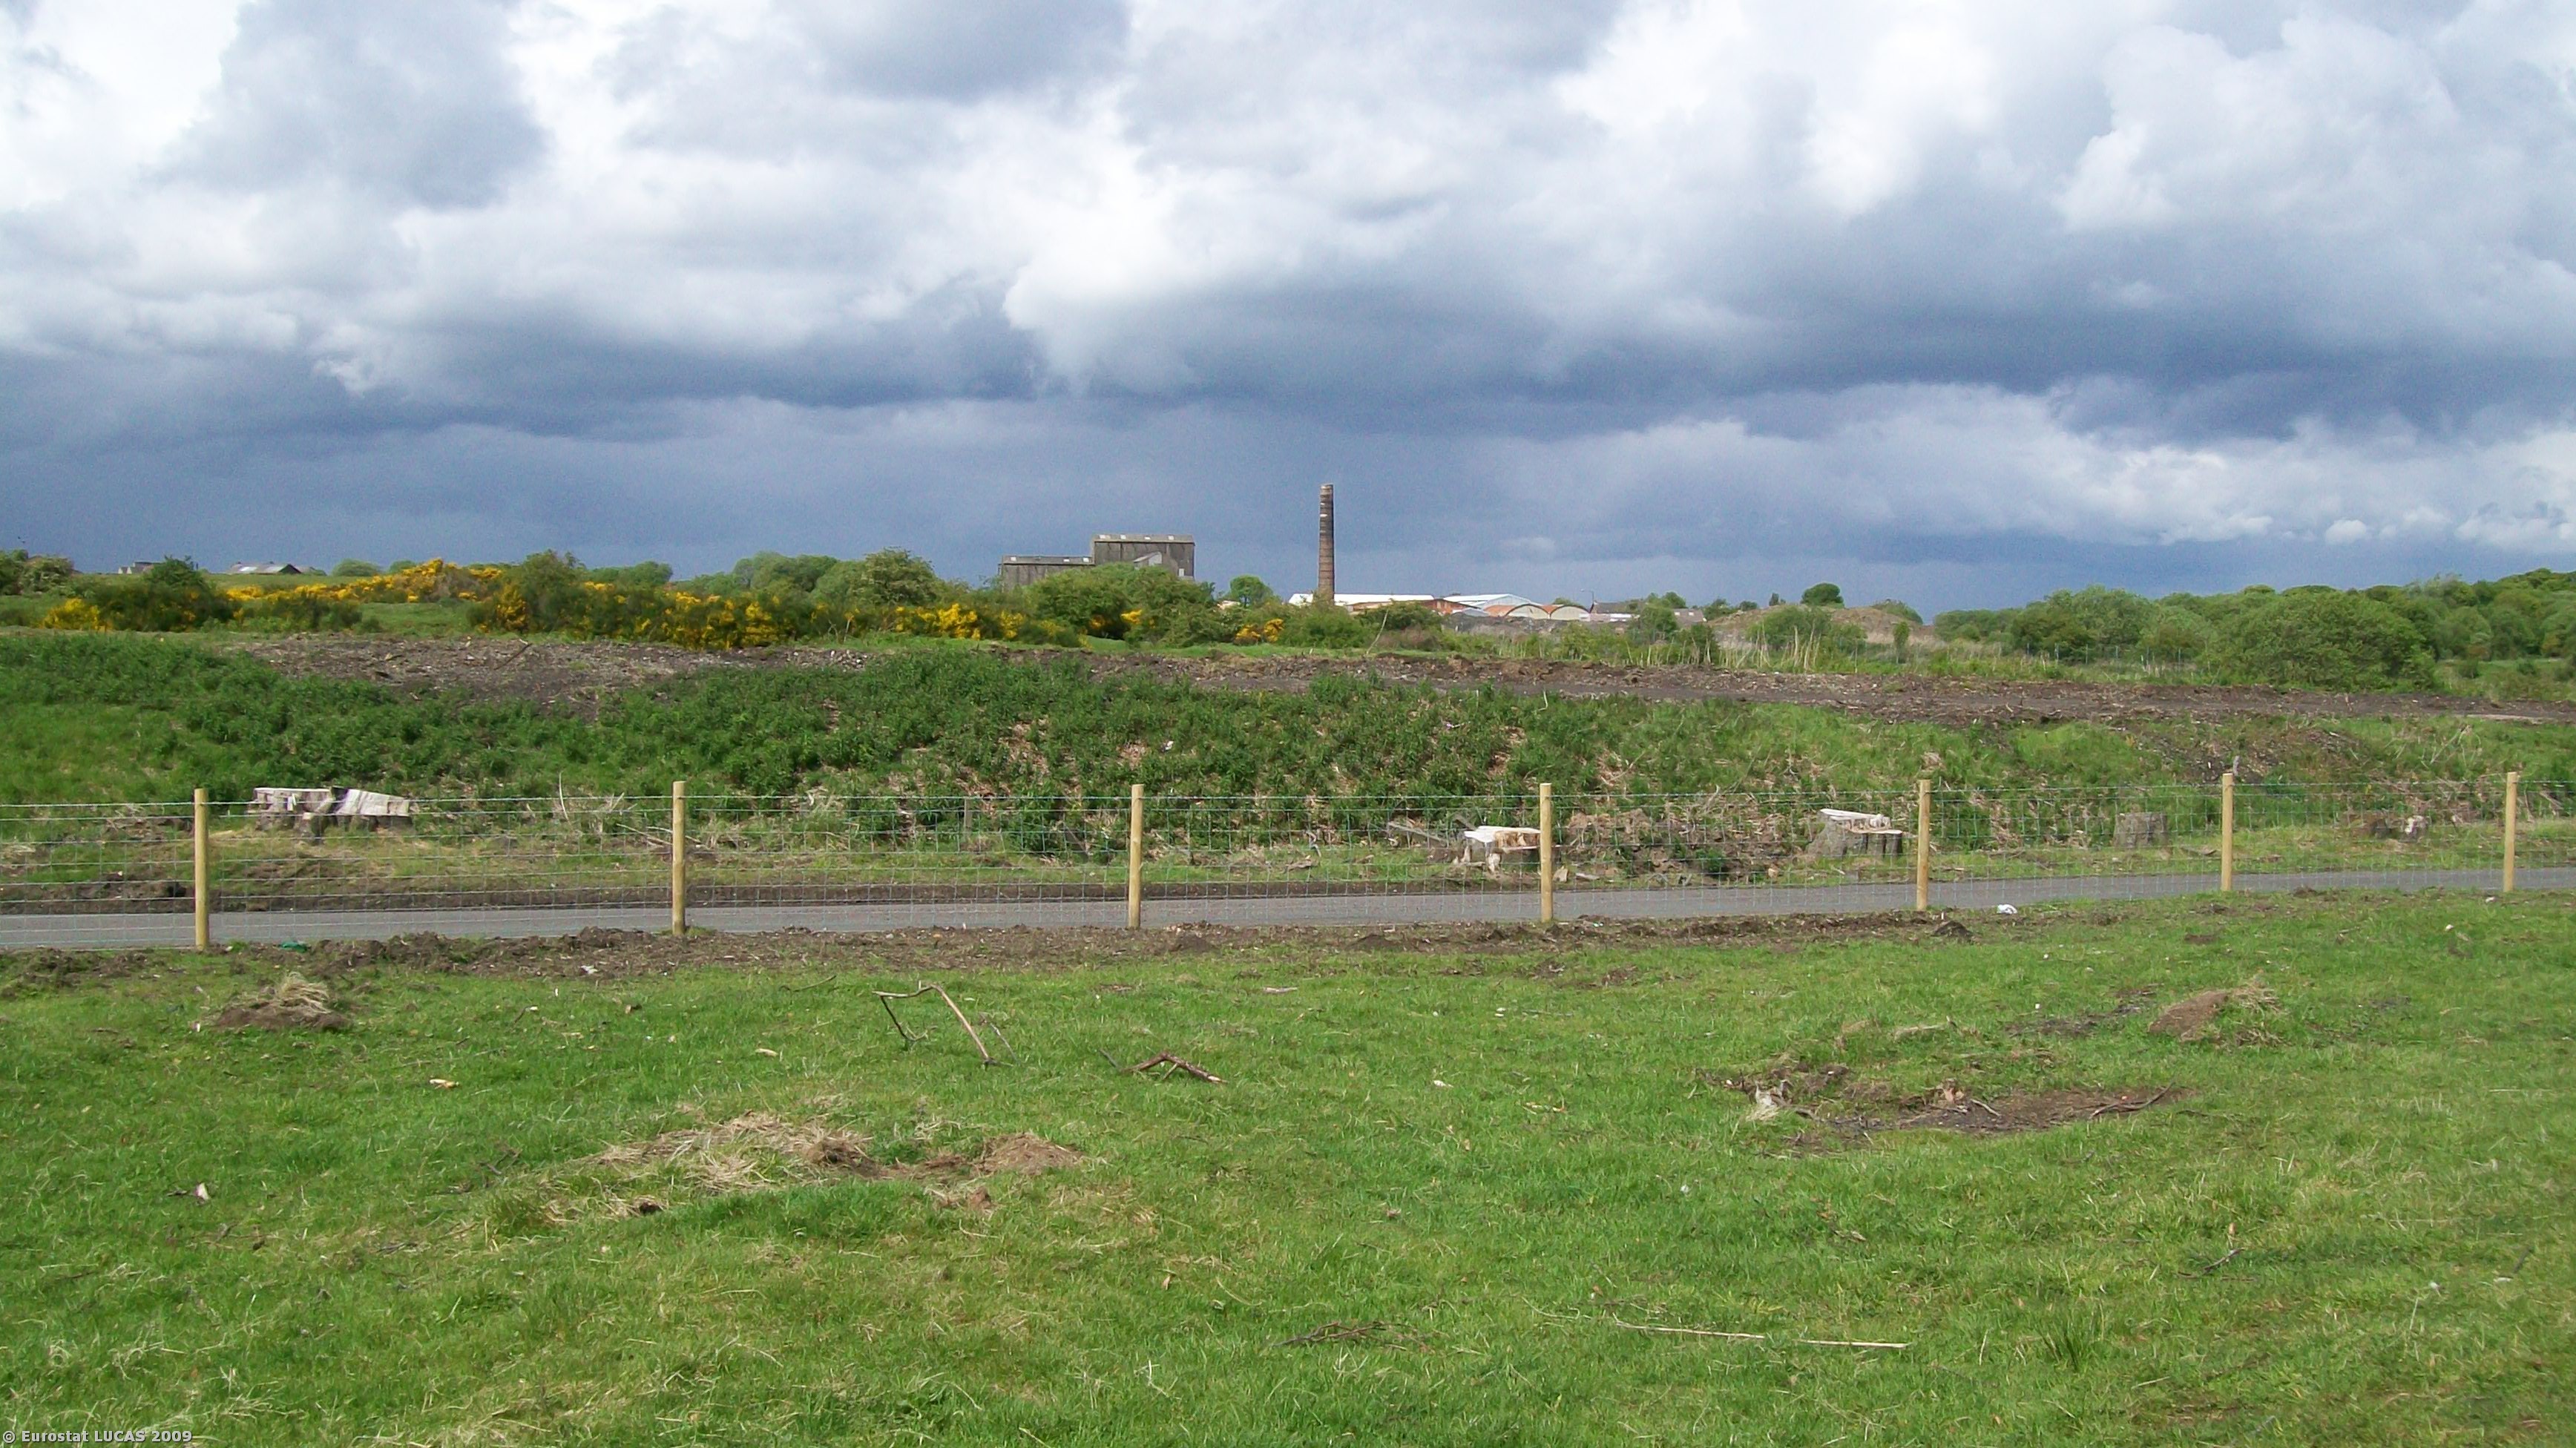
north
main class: Grassland
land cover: Grassland without tree/shrub cover
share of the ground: > 75 %
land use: Agriculture (excluding fallow land and kitchen gardens)
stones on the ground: 10 - 25 %
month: May
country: GB
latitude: 55.8880
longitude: -3.6875
